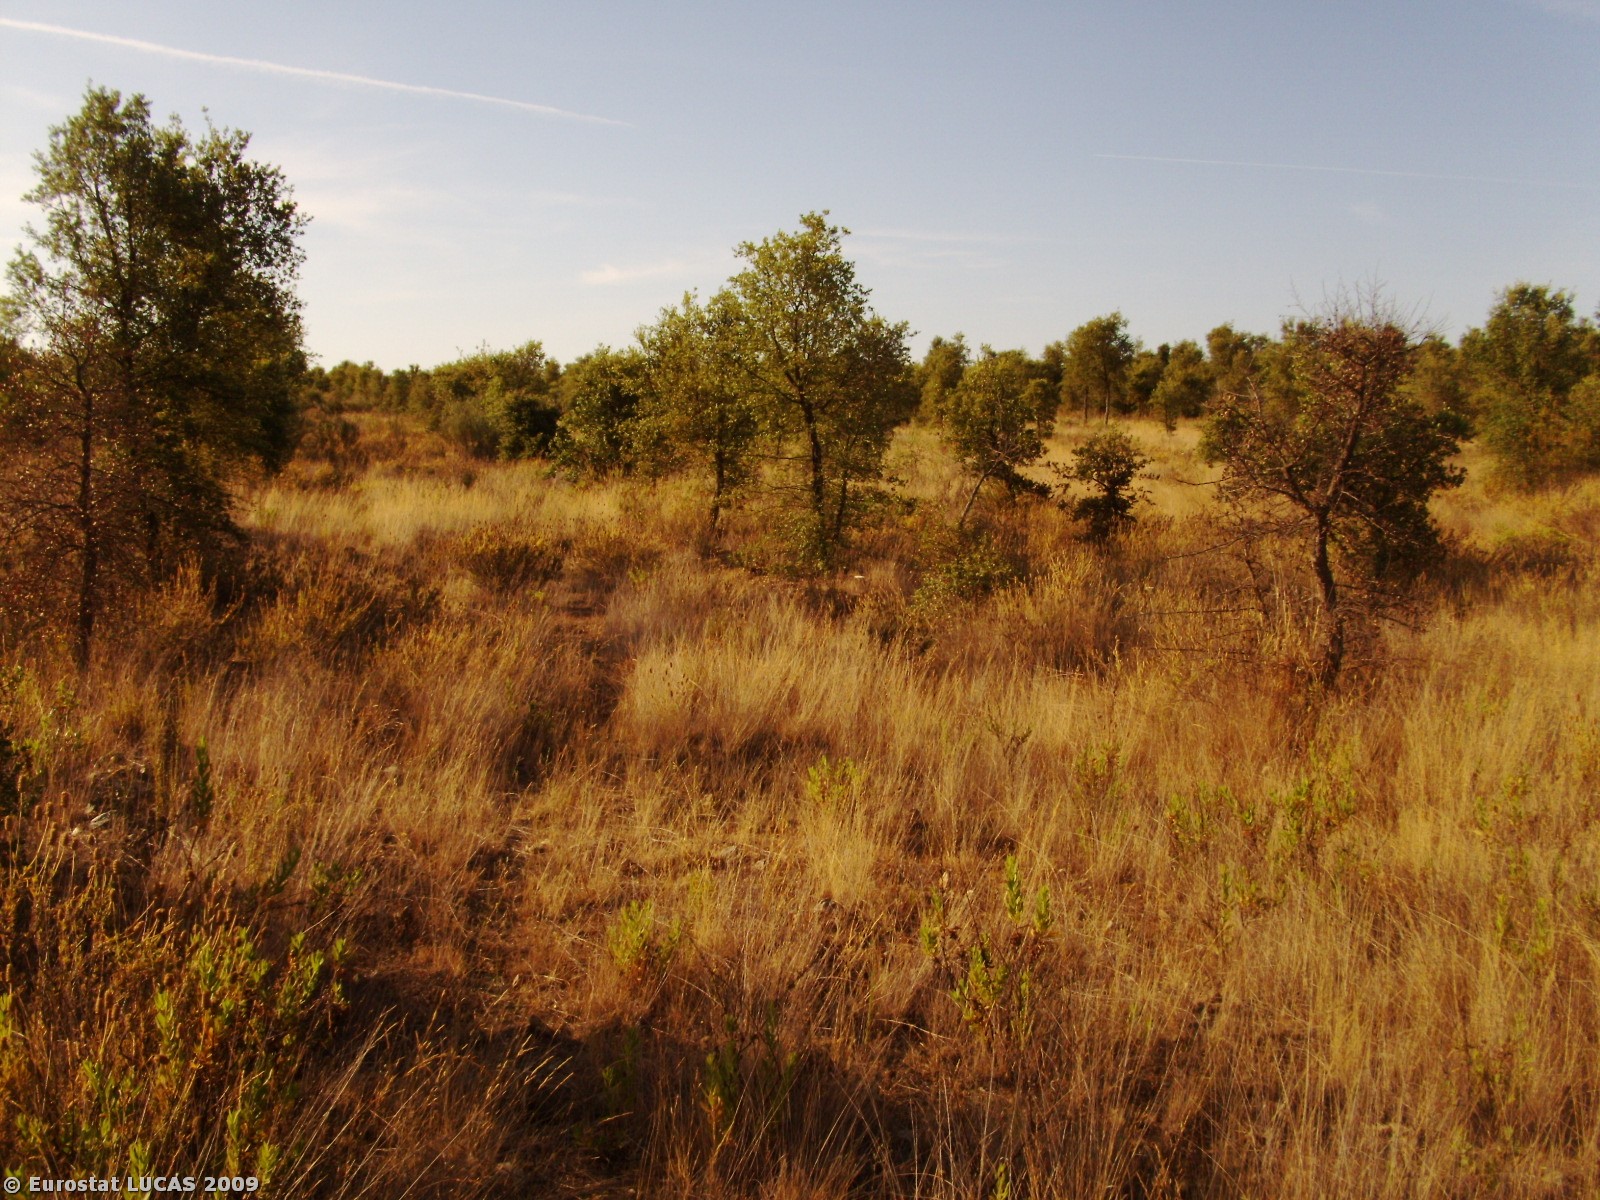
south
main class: Woodland
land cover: Broadleaved woodland
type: broadleaved evergreen forest
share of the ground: 25 - 50 %
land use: Forestry
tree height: > 5 m
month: June
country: PT
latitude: 40.0903
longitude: -7.2572
